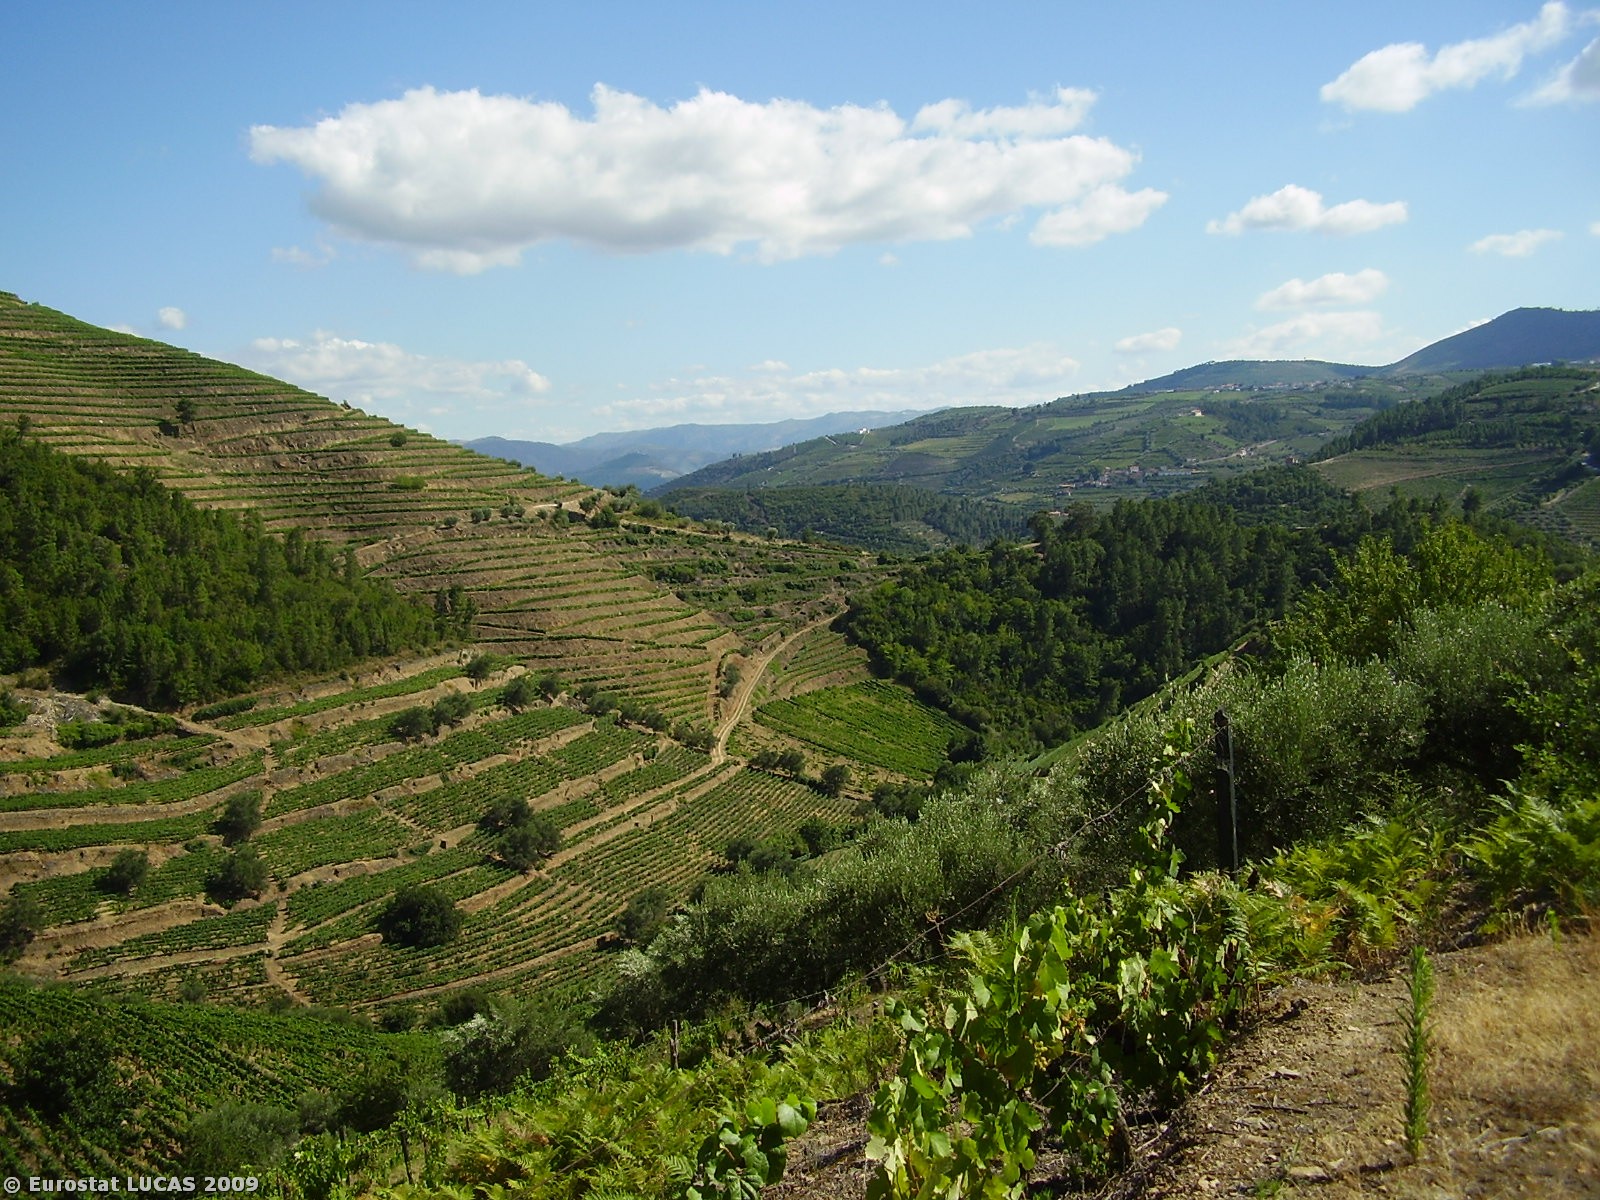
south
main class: Cropland
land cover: Vineyards
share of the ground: < 10 %
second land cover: Spontaneously vegetated surfaces
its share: 10 - 25 %
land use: Agriculture (excluding fallow land and kitchen gardens)
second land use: Unused
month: July
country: PT
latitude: 41.2748
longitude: -7.5426
